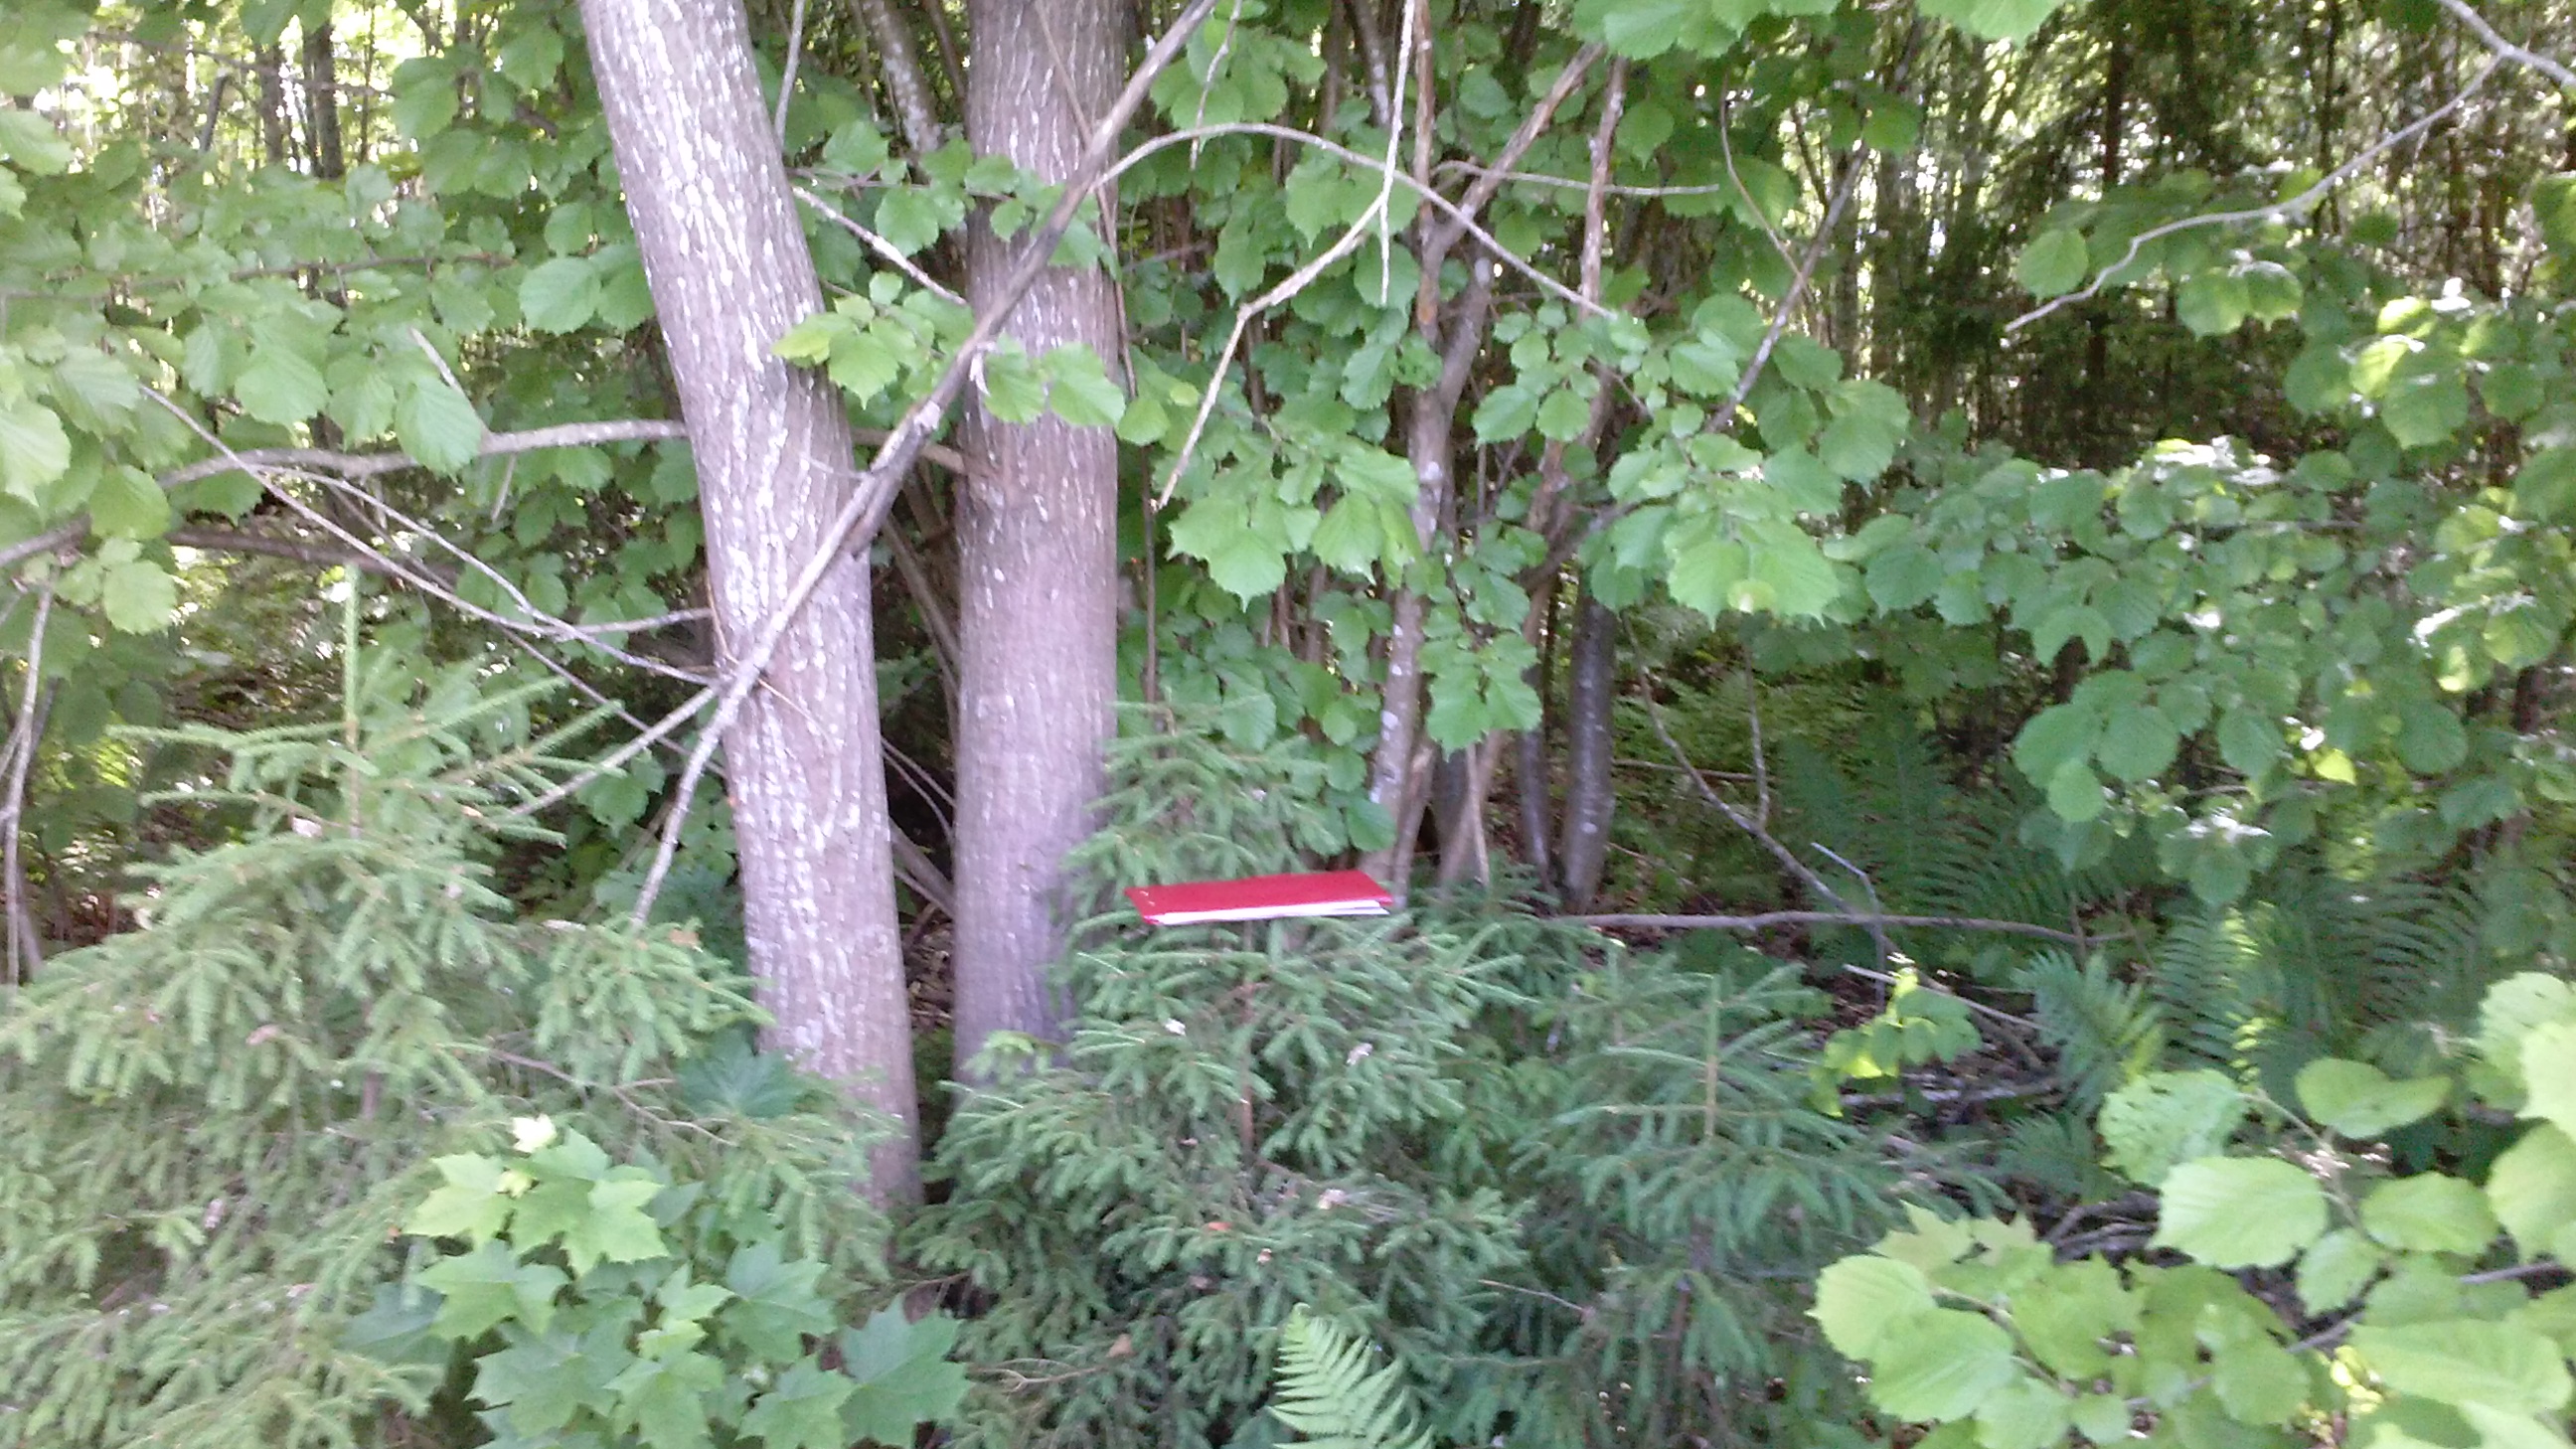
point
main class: Woodland
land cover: Broadleaved woodland
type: non-riverine alder, birch or aspen forest
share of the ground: > 75 %
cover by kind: broadleaved forest trees 80 %, herbaceous plants 10 %, coniferous forest trees 5 %, shrubs 5 %
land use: Forestry
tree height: > 5 m
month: June
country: LV
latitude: 56.5172
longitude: 27.9254
